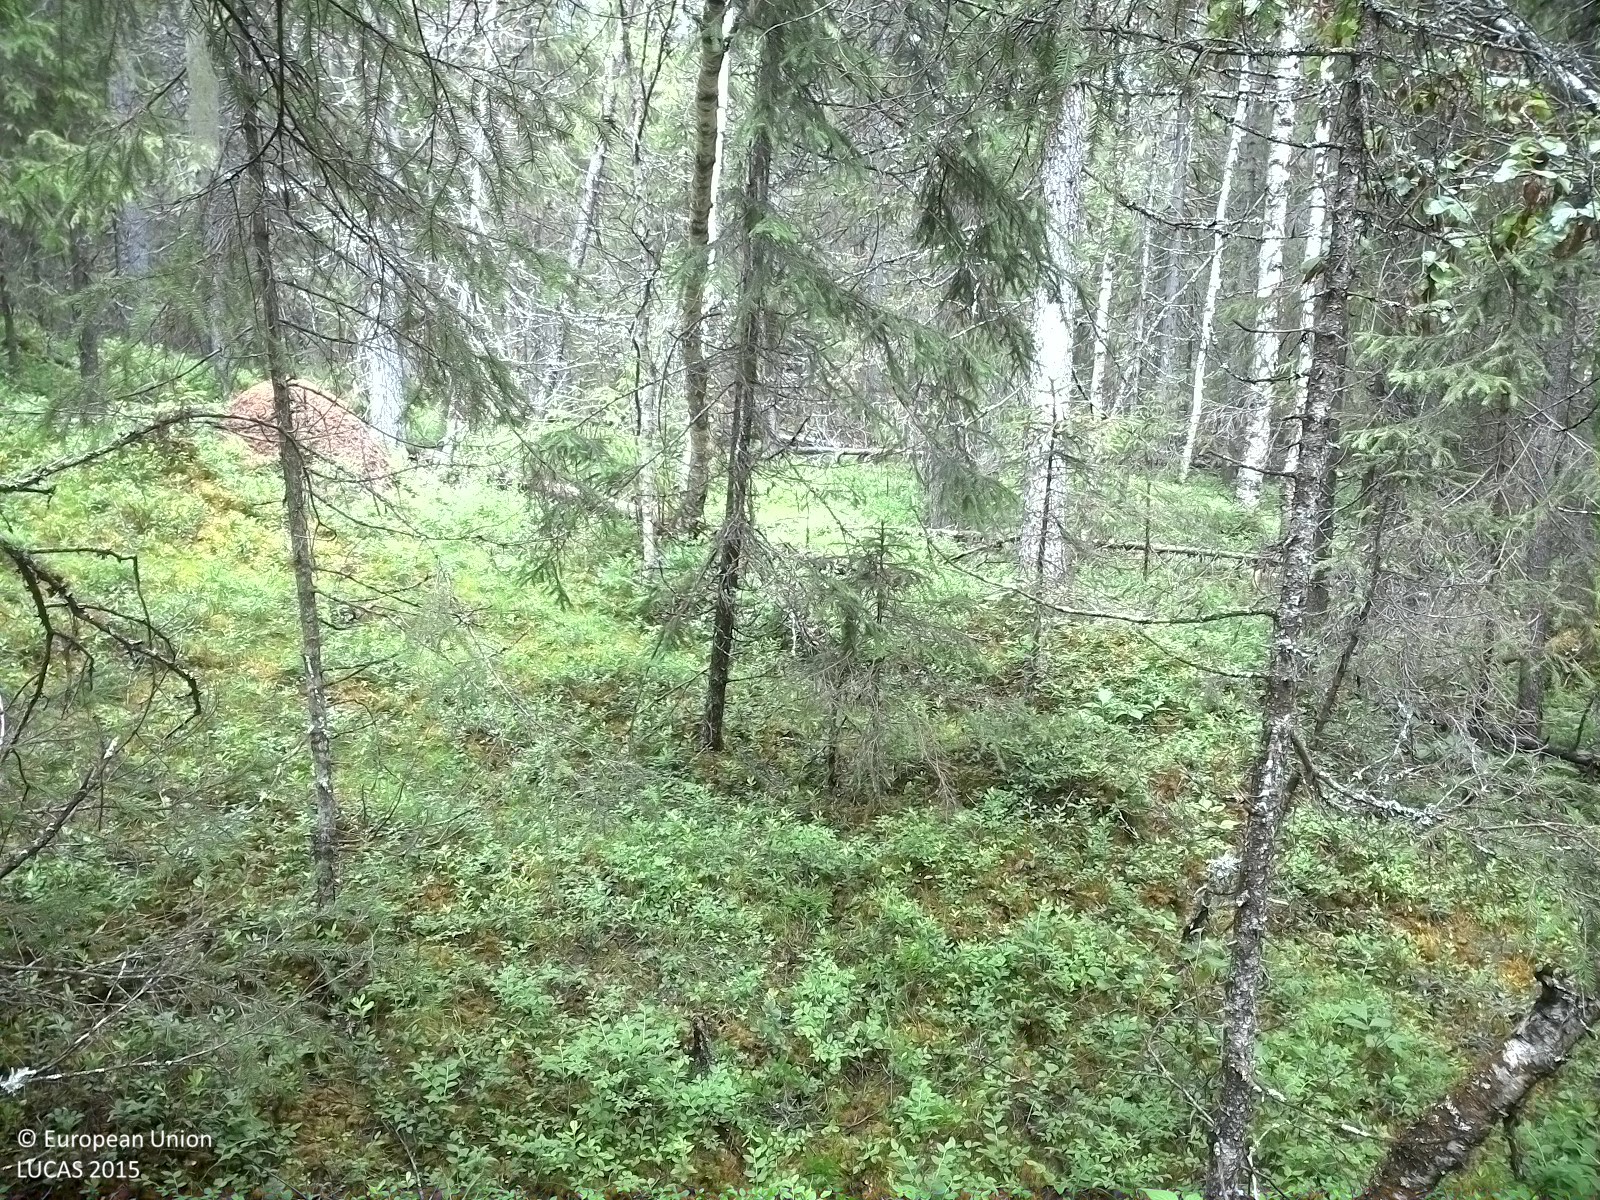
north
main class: Woodland
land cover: Spruce dominated coniferous woodland
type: boreal forest
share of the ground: > 75 %
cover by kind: coniferous forest trees 80 %, shrubs 15 %, broadleaved forest trees 5 %
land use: Forestry
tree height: > 5 m
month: July
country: SE
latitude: 63.5674
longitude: 15.3111
